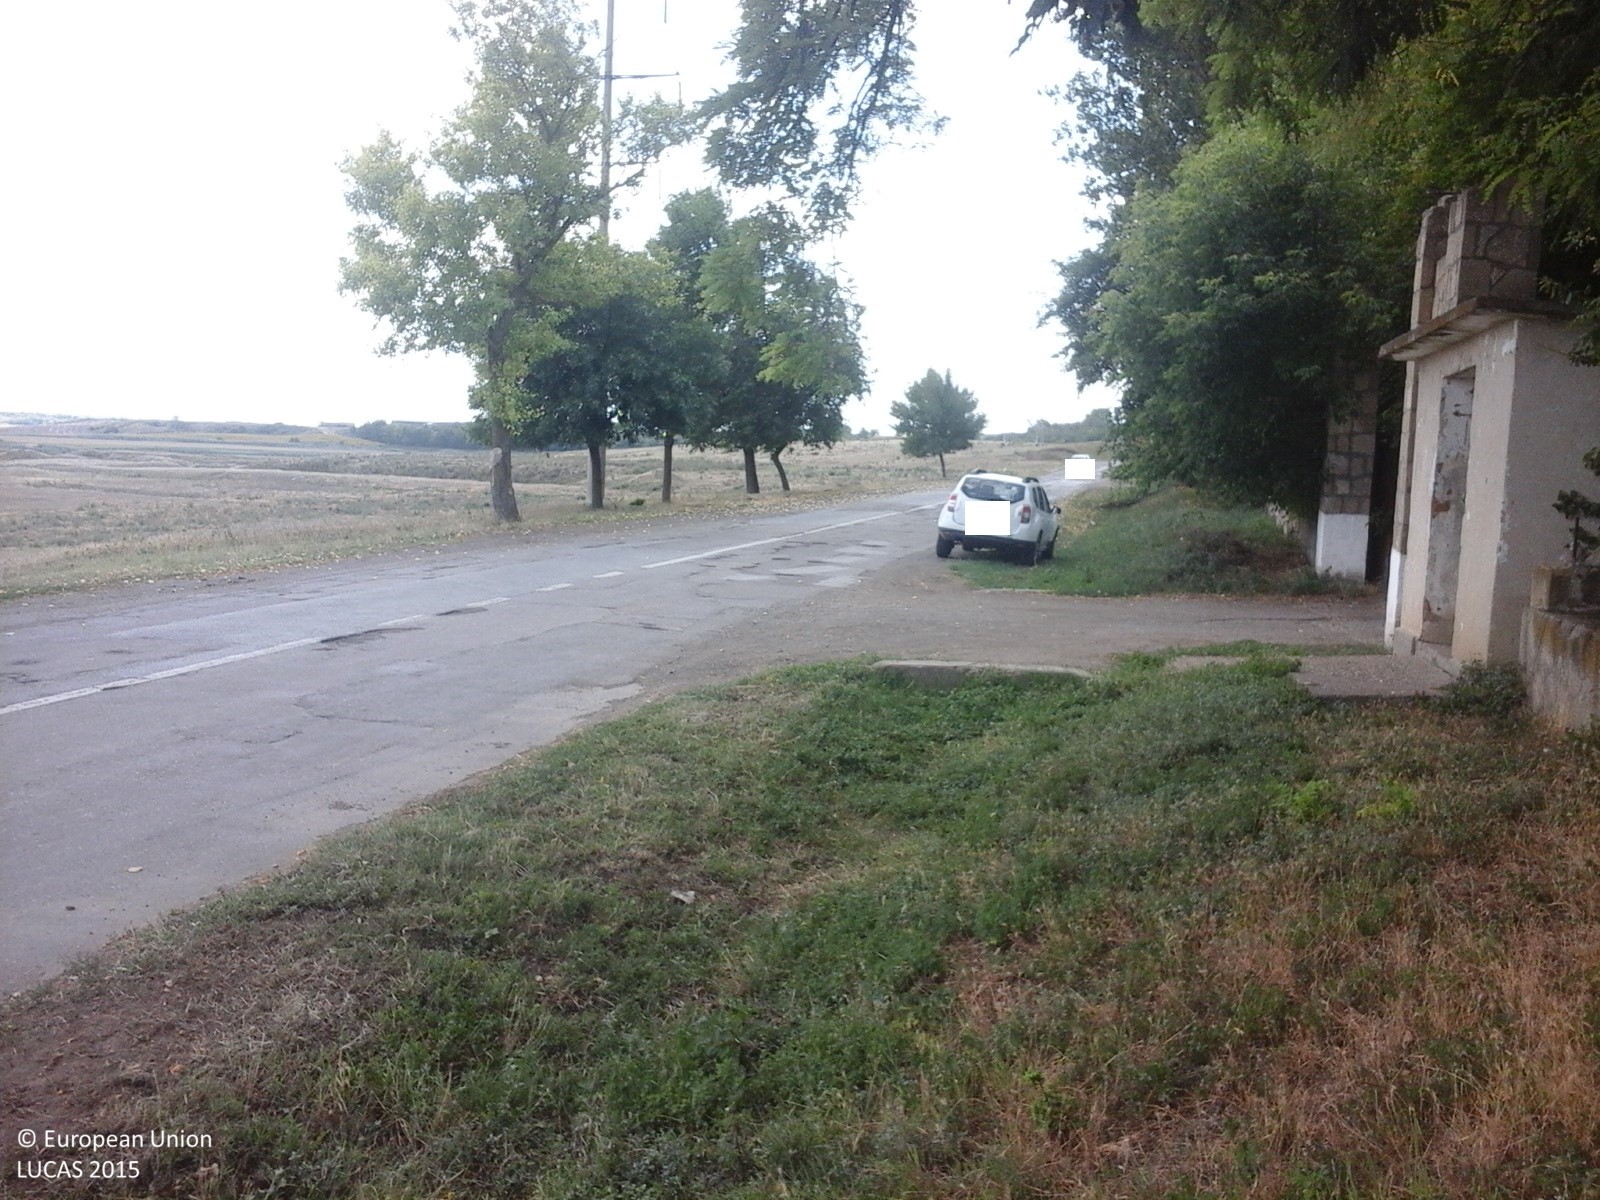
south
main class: Grassland
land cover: Grassland without tree/shrub cover
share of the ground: > 75 %
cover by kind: herbaceous plants 100 %
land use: Residential
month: July
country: RO
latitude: 46.4704
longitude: 28.1957
